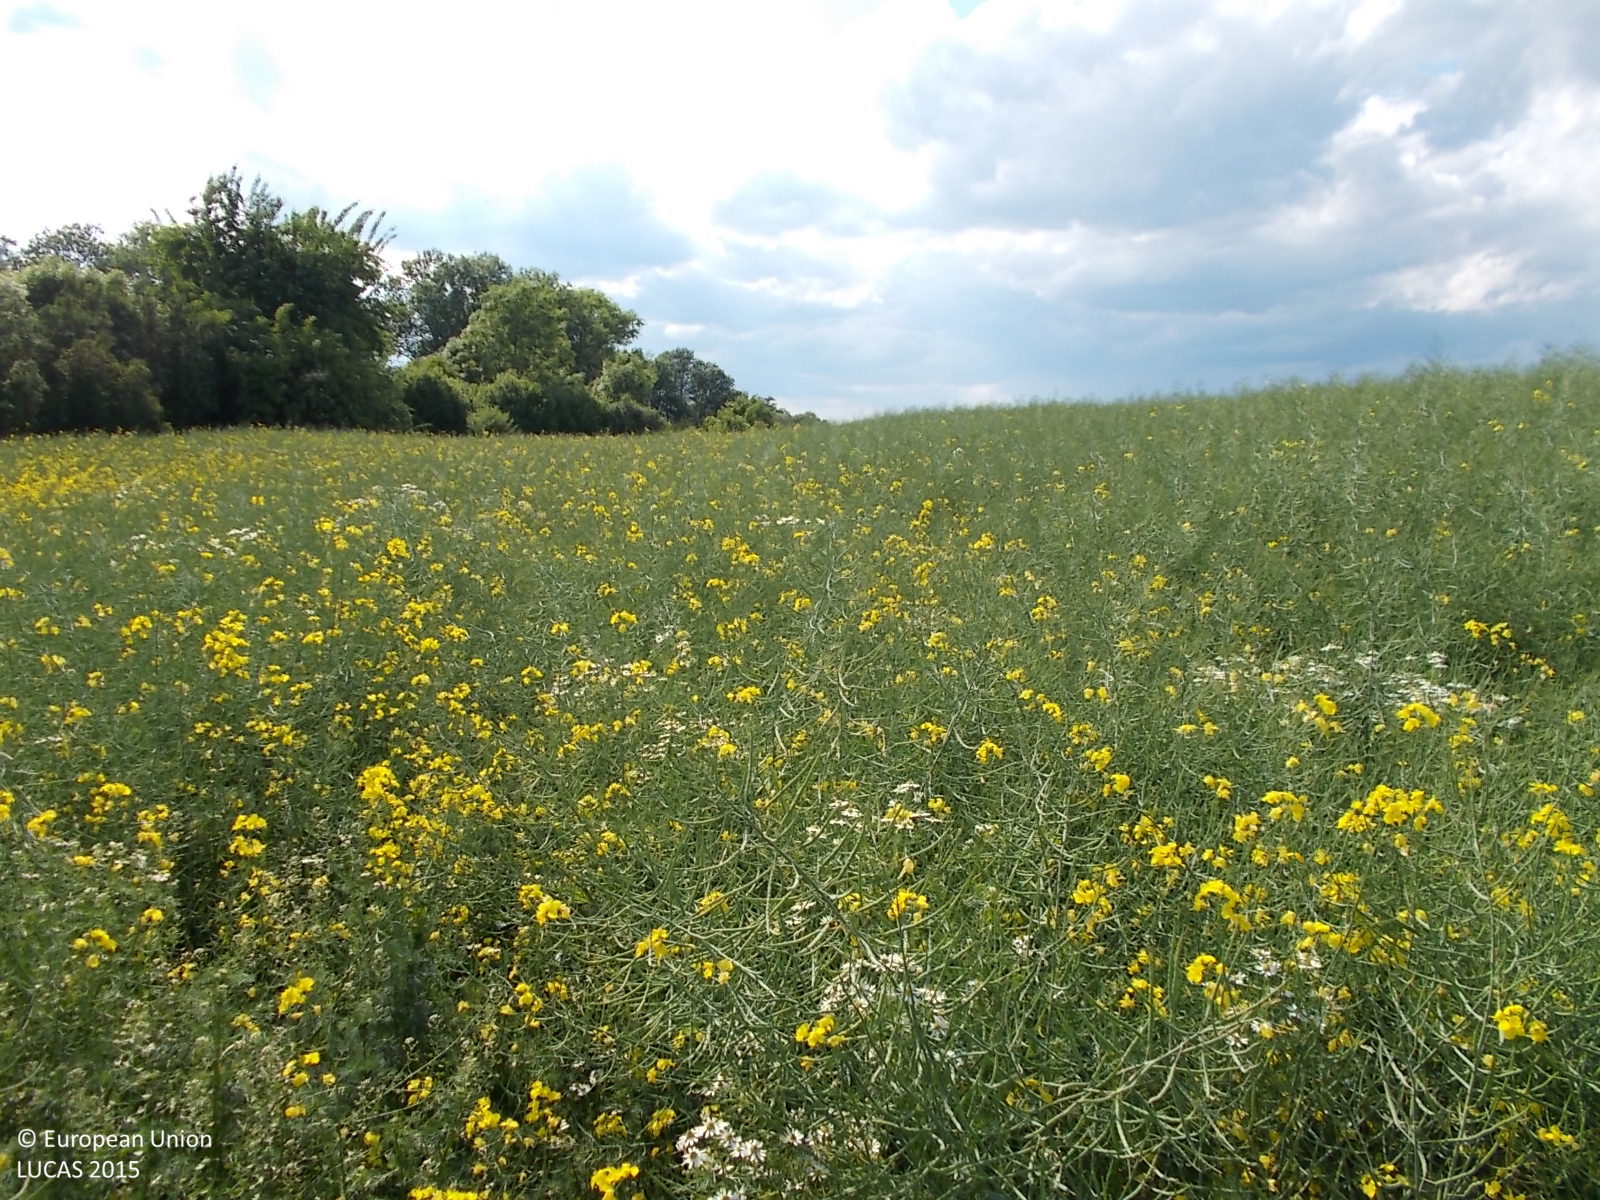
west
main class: Cropland
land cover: Rape and turnip rape
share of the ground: > 75 %
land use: Agriculture (excluding fallow land and kitchen gardens)
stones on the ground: < 10 %
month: June
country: CZ
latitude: 49.9420
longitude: 15.1448
